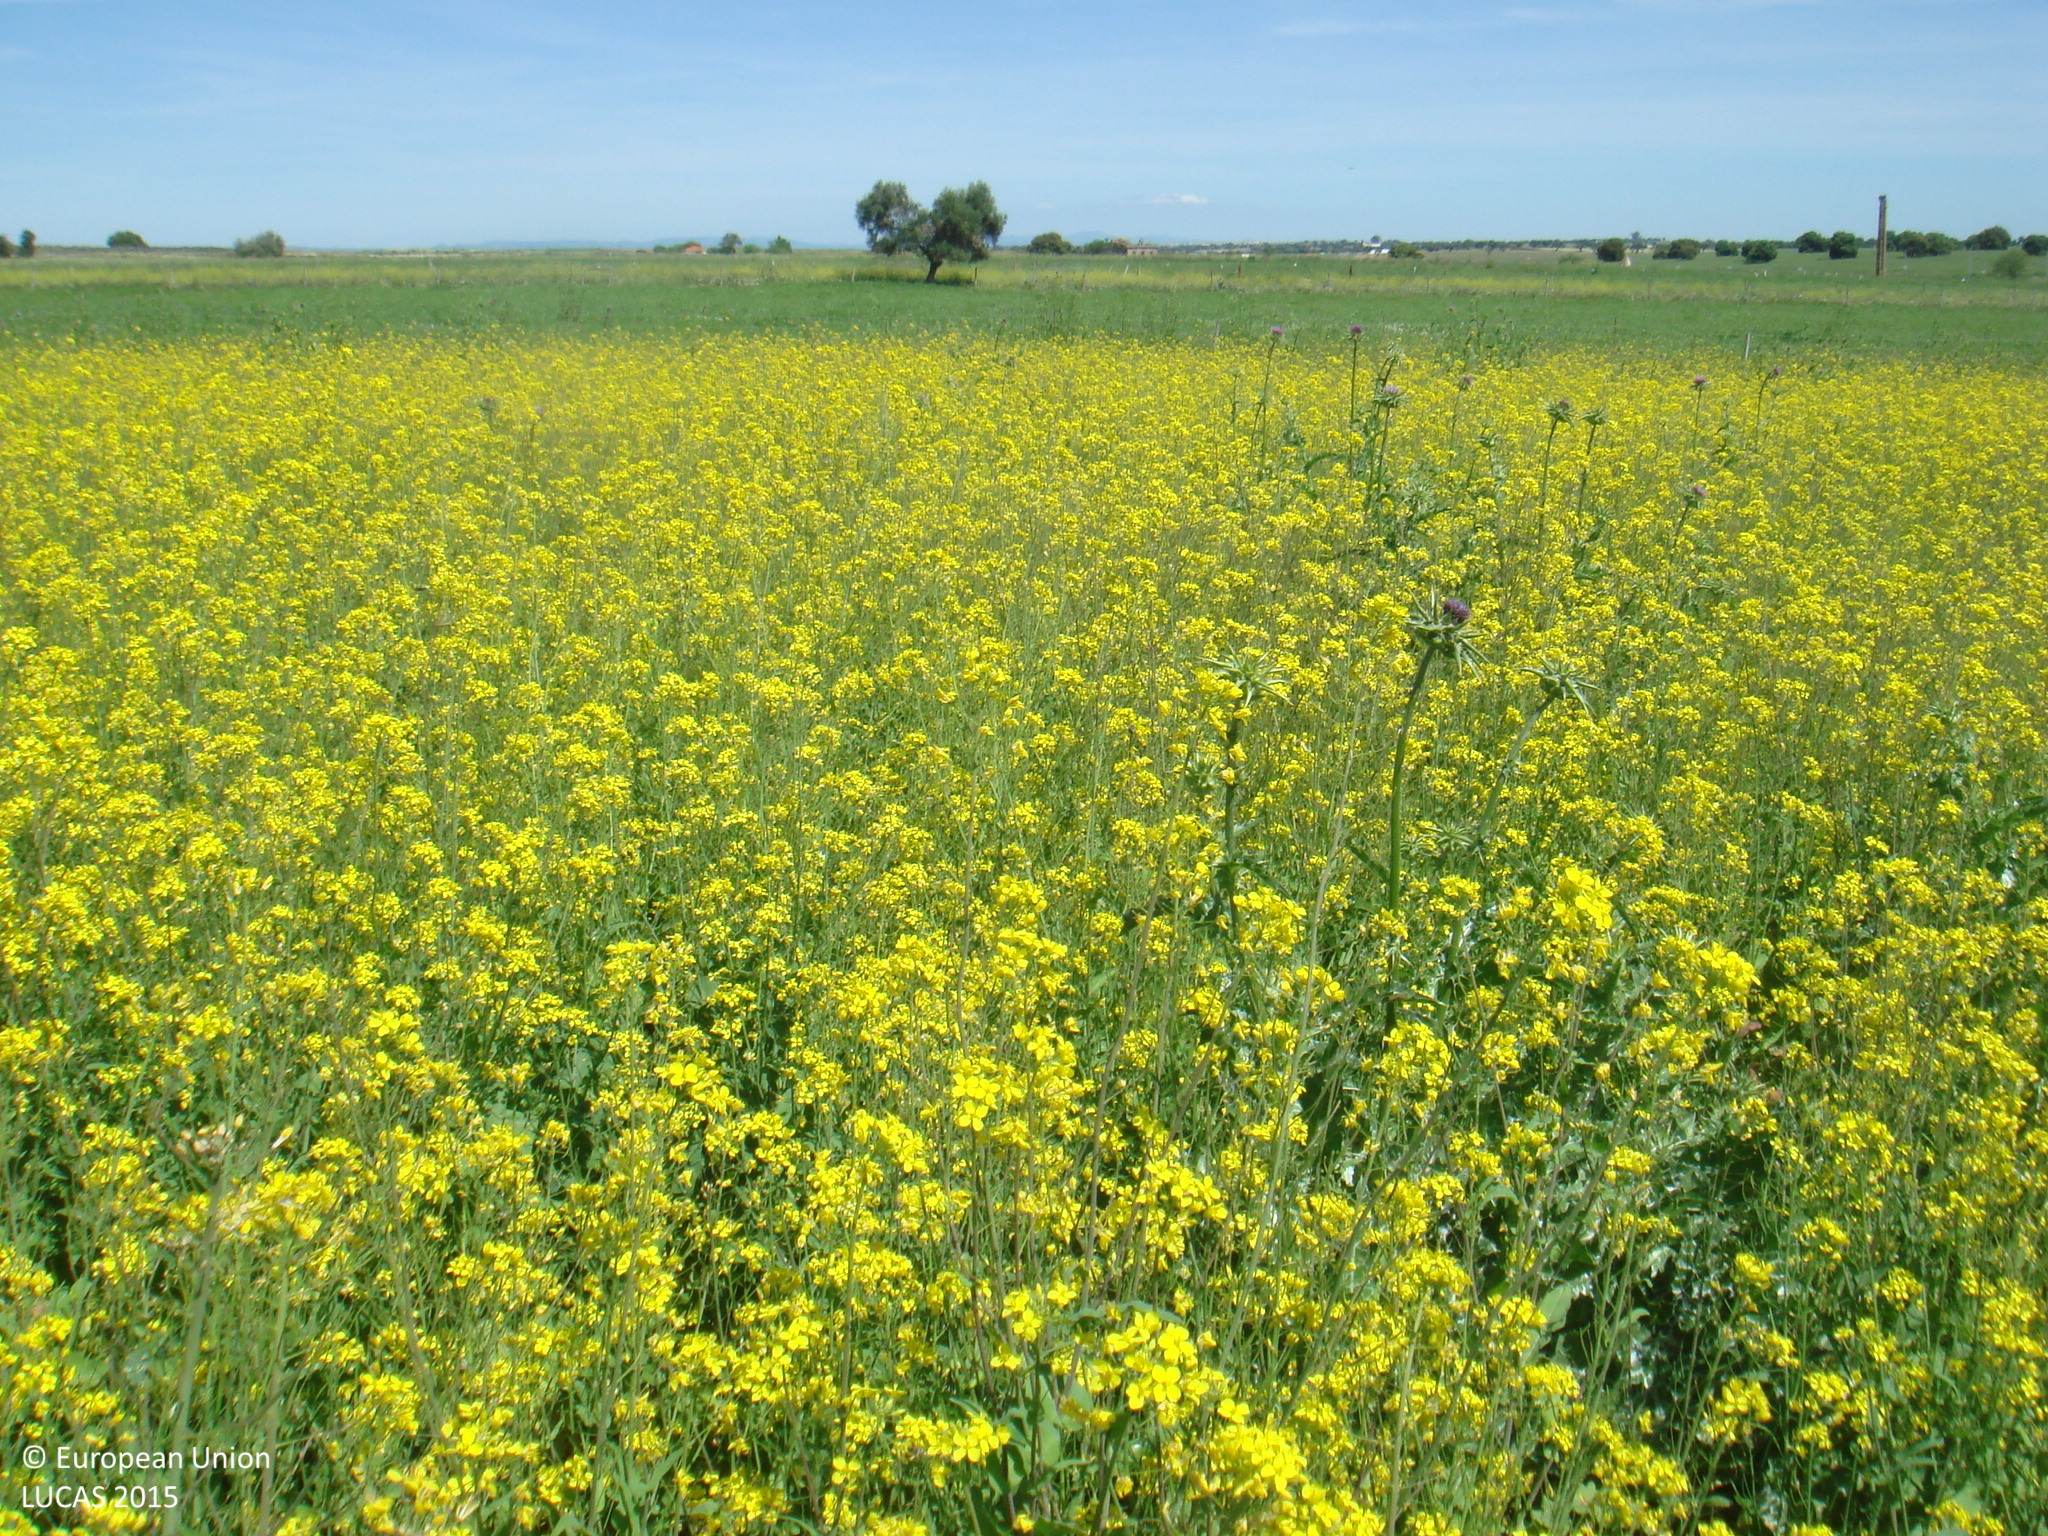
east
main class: Grassland
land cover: Spontaneously vegetated surfaces
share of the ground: > 75 %
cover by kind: herbaceous plants 95 %, shrubs 5 %
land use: Fallow land
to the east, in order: Spontaneously vegetated surfaces; Fences; Spontaneously vegetated surfaces; Fences; Grass margins; Tracks; Grass margins; Fences; Spontaneously vegetated surfaces; Fences; Spontaneously vegetated surfaces; Fences; Spontaneously vegetated surfaces; Fences; Spontaneously vegetated surfaces
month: April
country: ES
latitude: 38.5017
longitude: -5.1079
